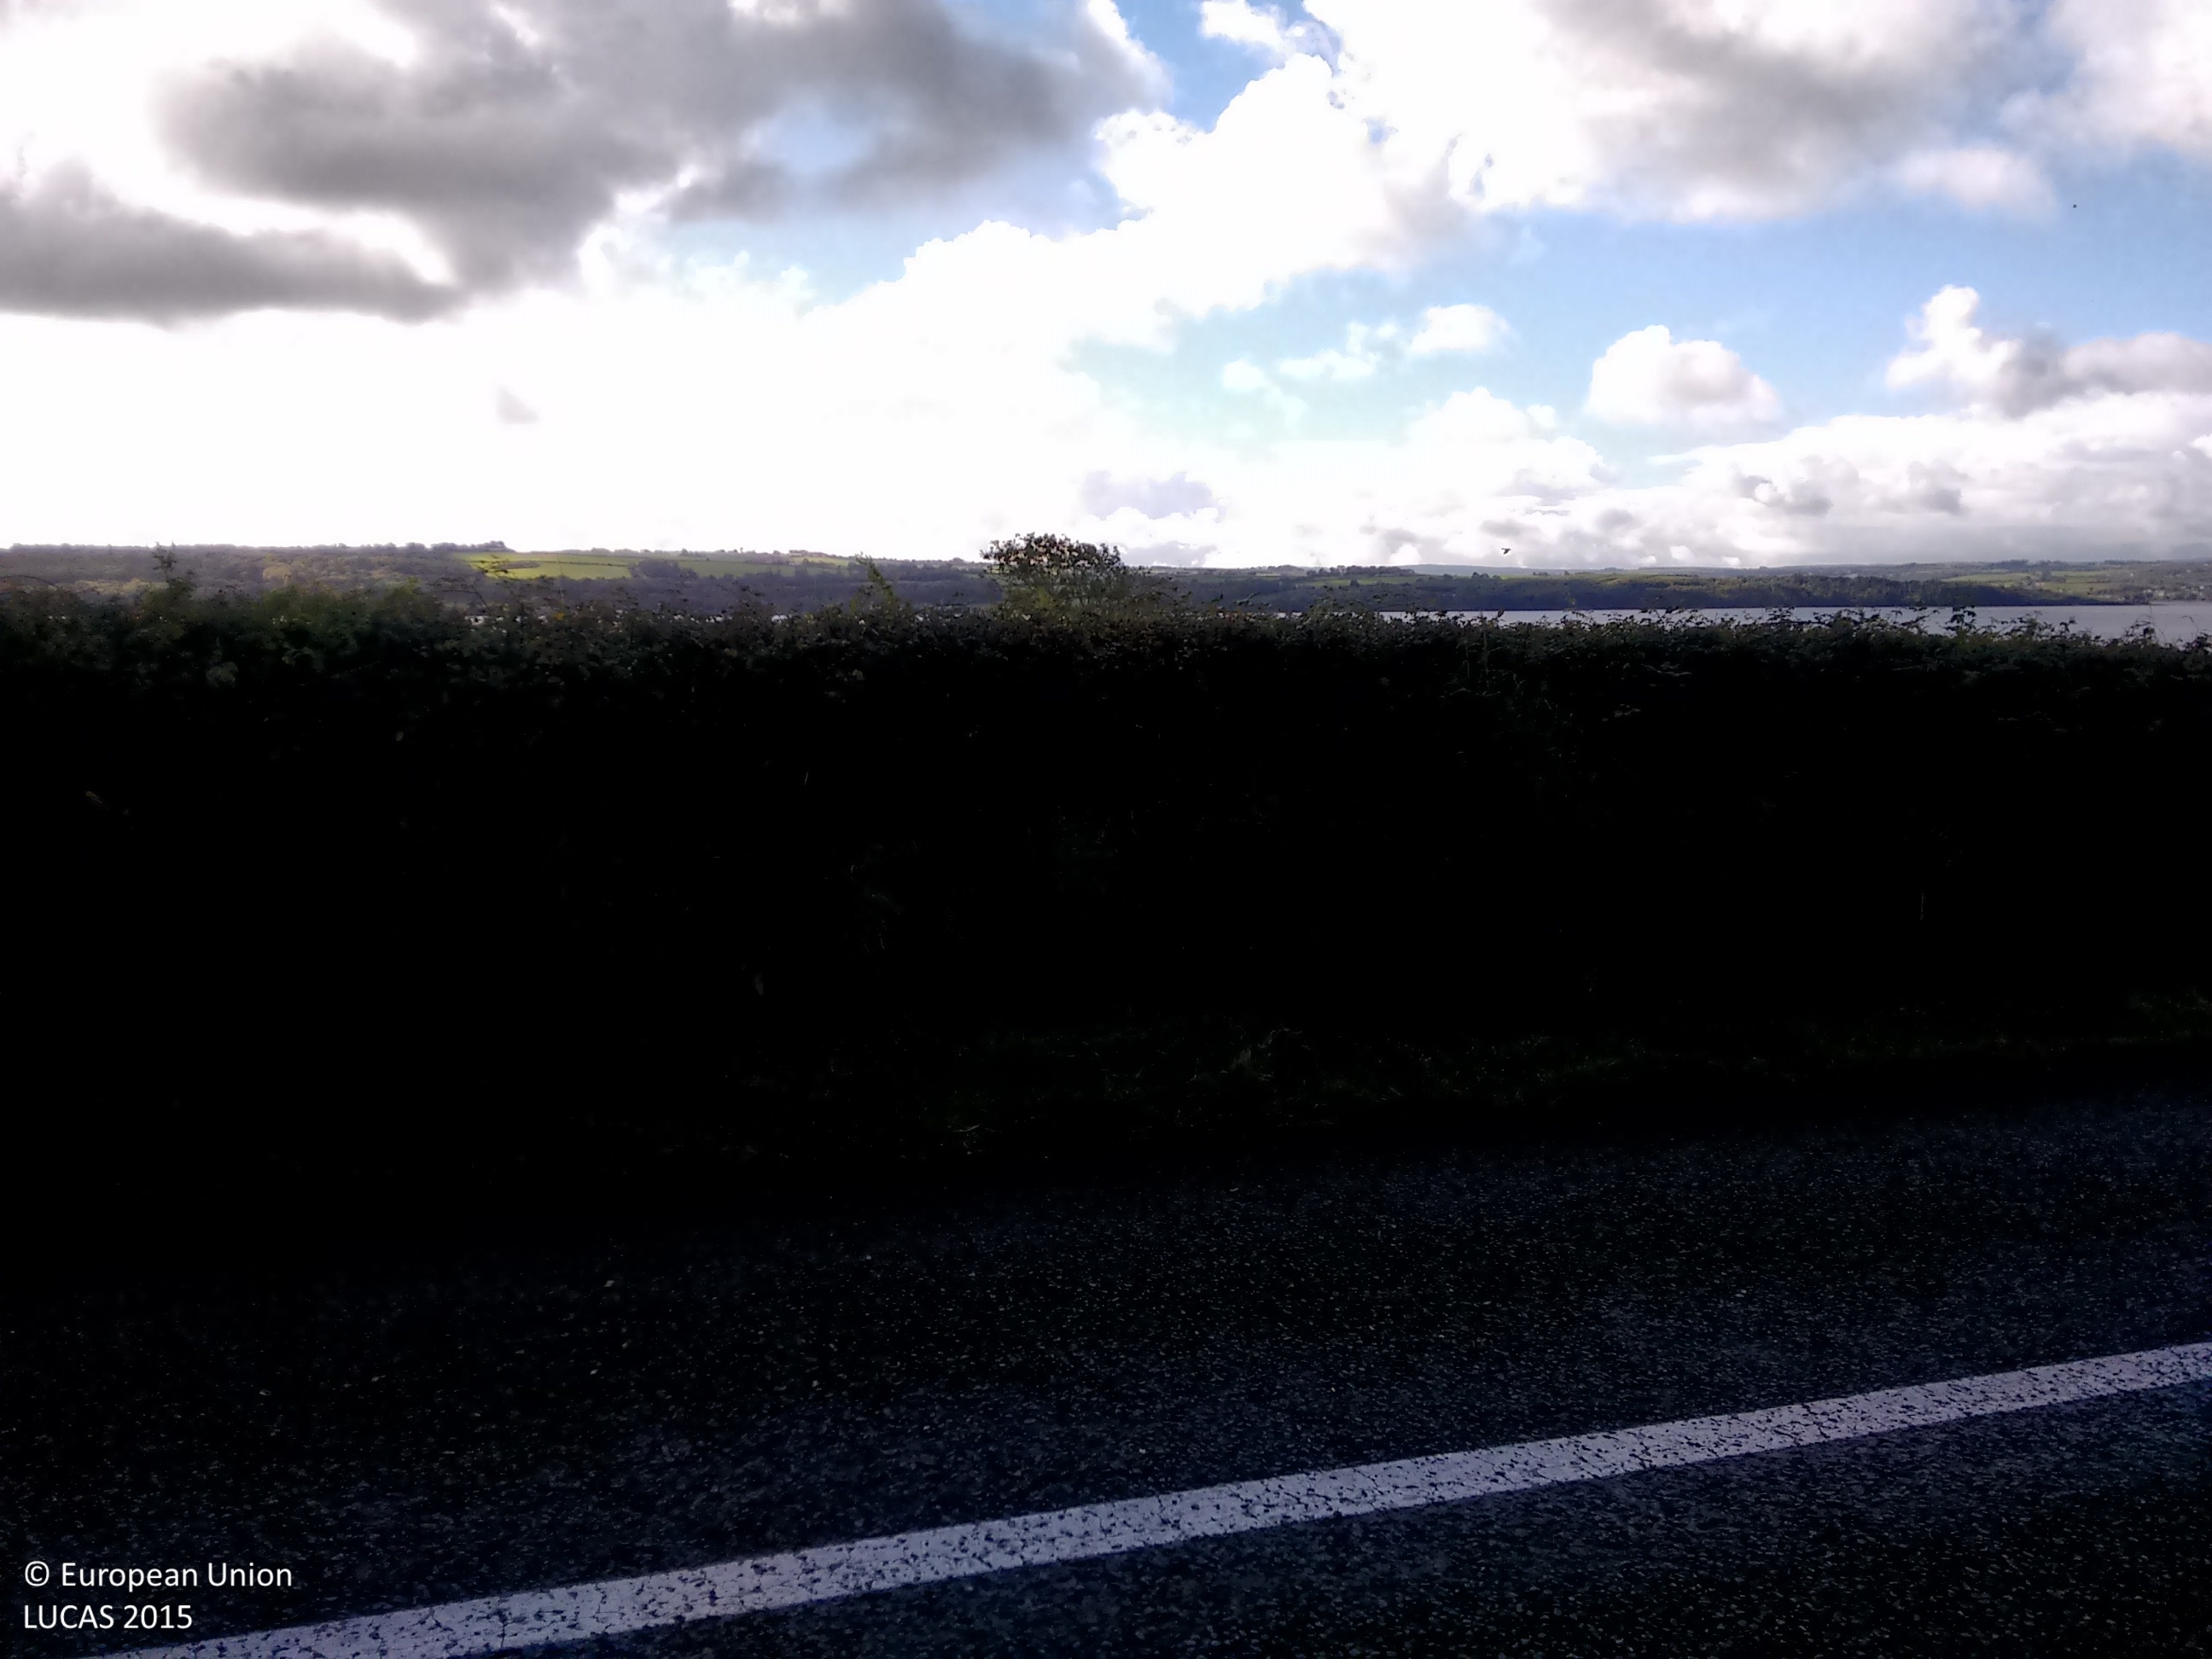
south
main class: Grassland
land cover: Grassland without tree/shrub cover
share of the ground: > 75 %
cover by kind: herbaceous plants 100 %
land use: Agriculture (excluding fallow land and kitchen gardens)
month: September
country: IE
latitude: 52.6253
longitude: -9.1734
